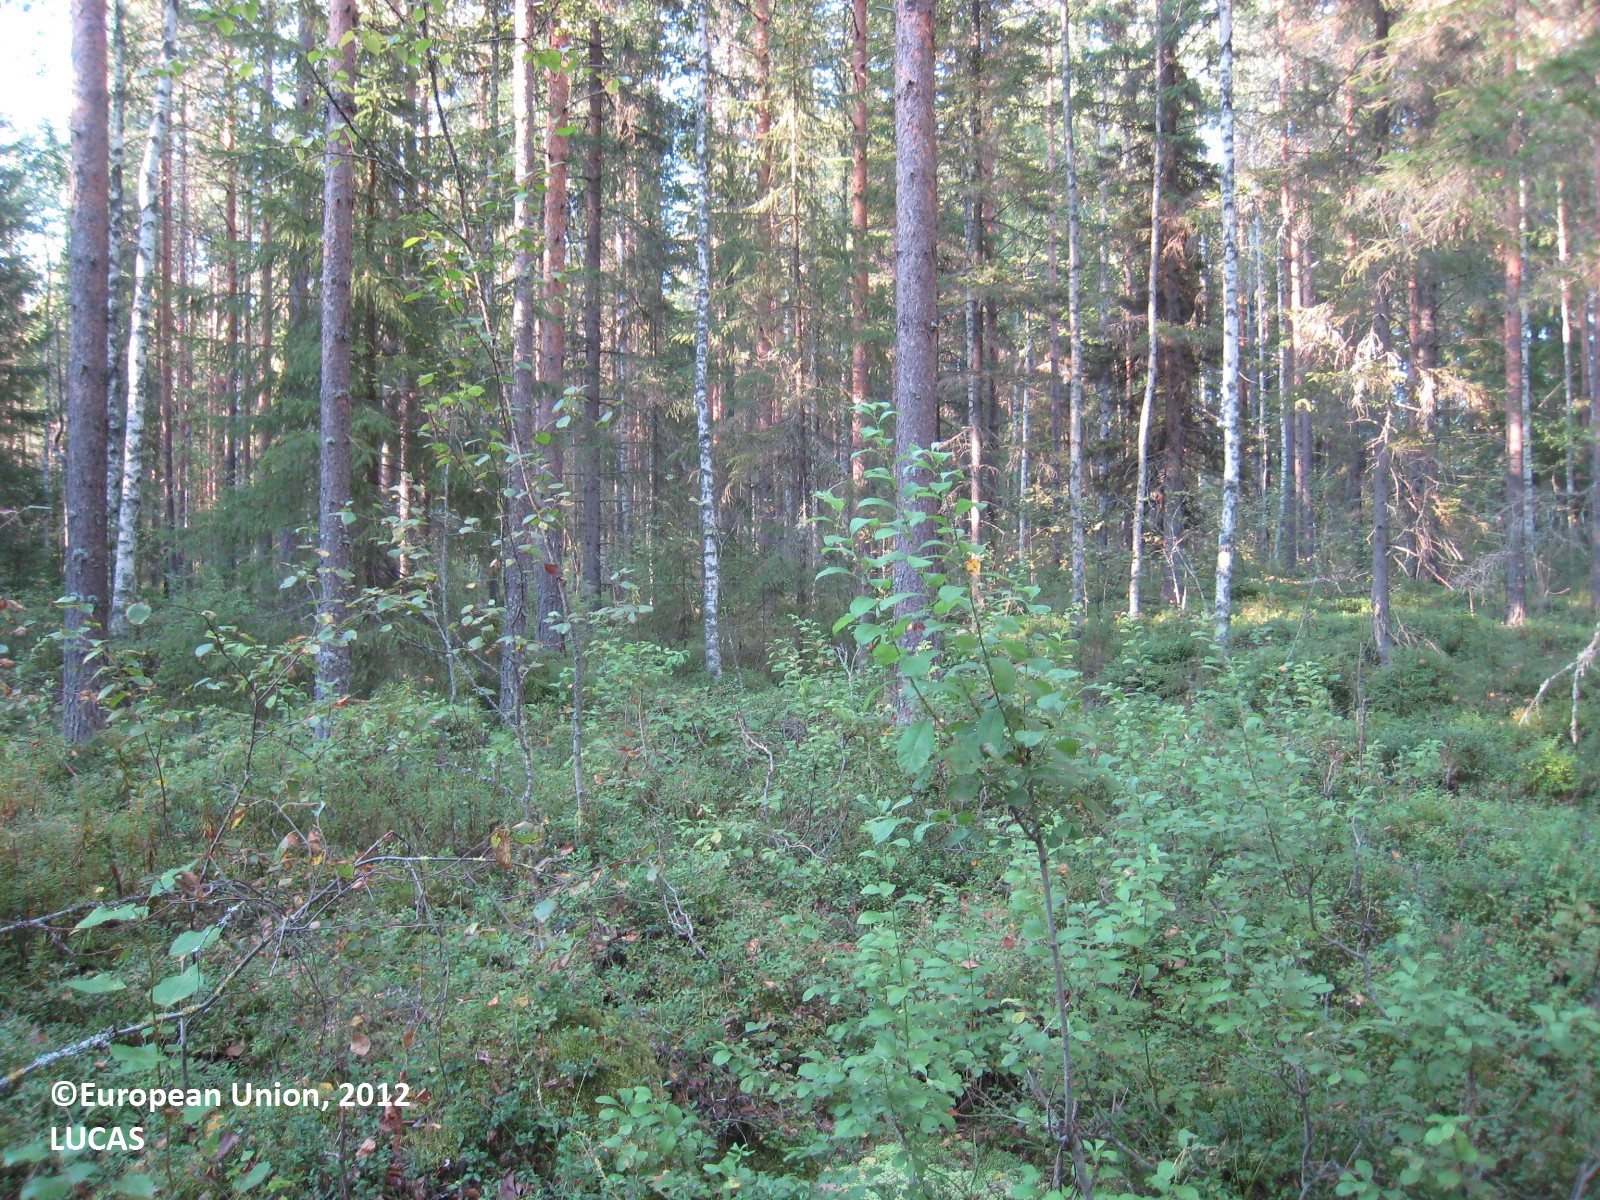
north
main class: Woodland
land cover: Other mixed woodland
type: boreal forest
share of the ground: > 75 %
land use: Forestry
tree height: > 5 m
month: August
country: FI
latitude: 62.1024
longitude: 27.2725
